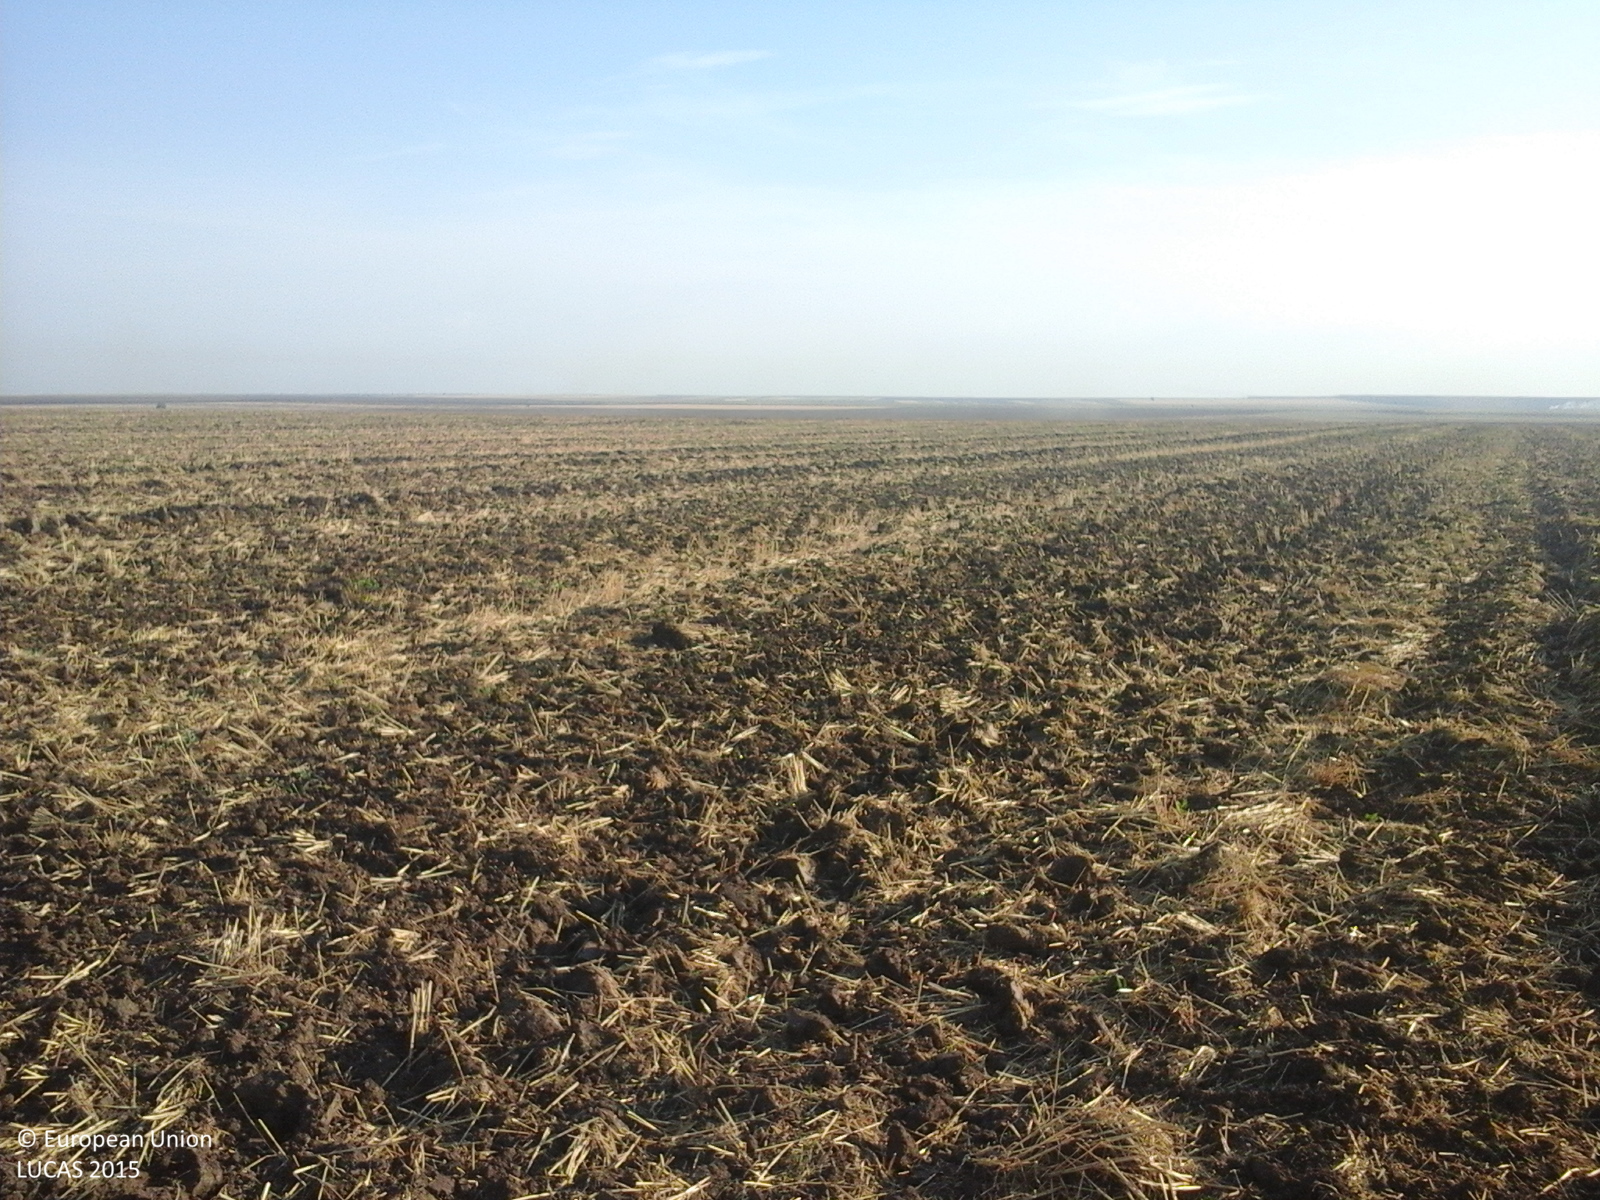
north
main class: Cropland
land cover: Common wheat
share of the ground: < 10 %
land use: Agriculture (excluding fallow land and kitchen gardens)
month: August
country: RO
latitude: 44.1922
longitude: 23.0937
